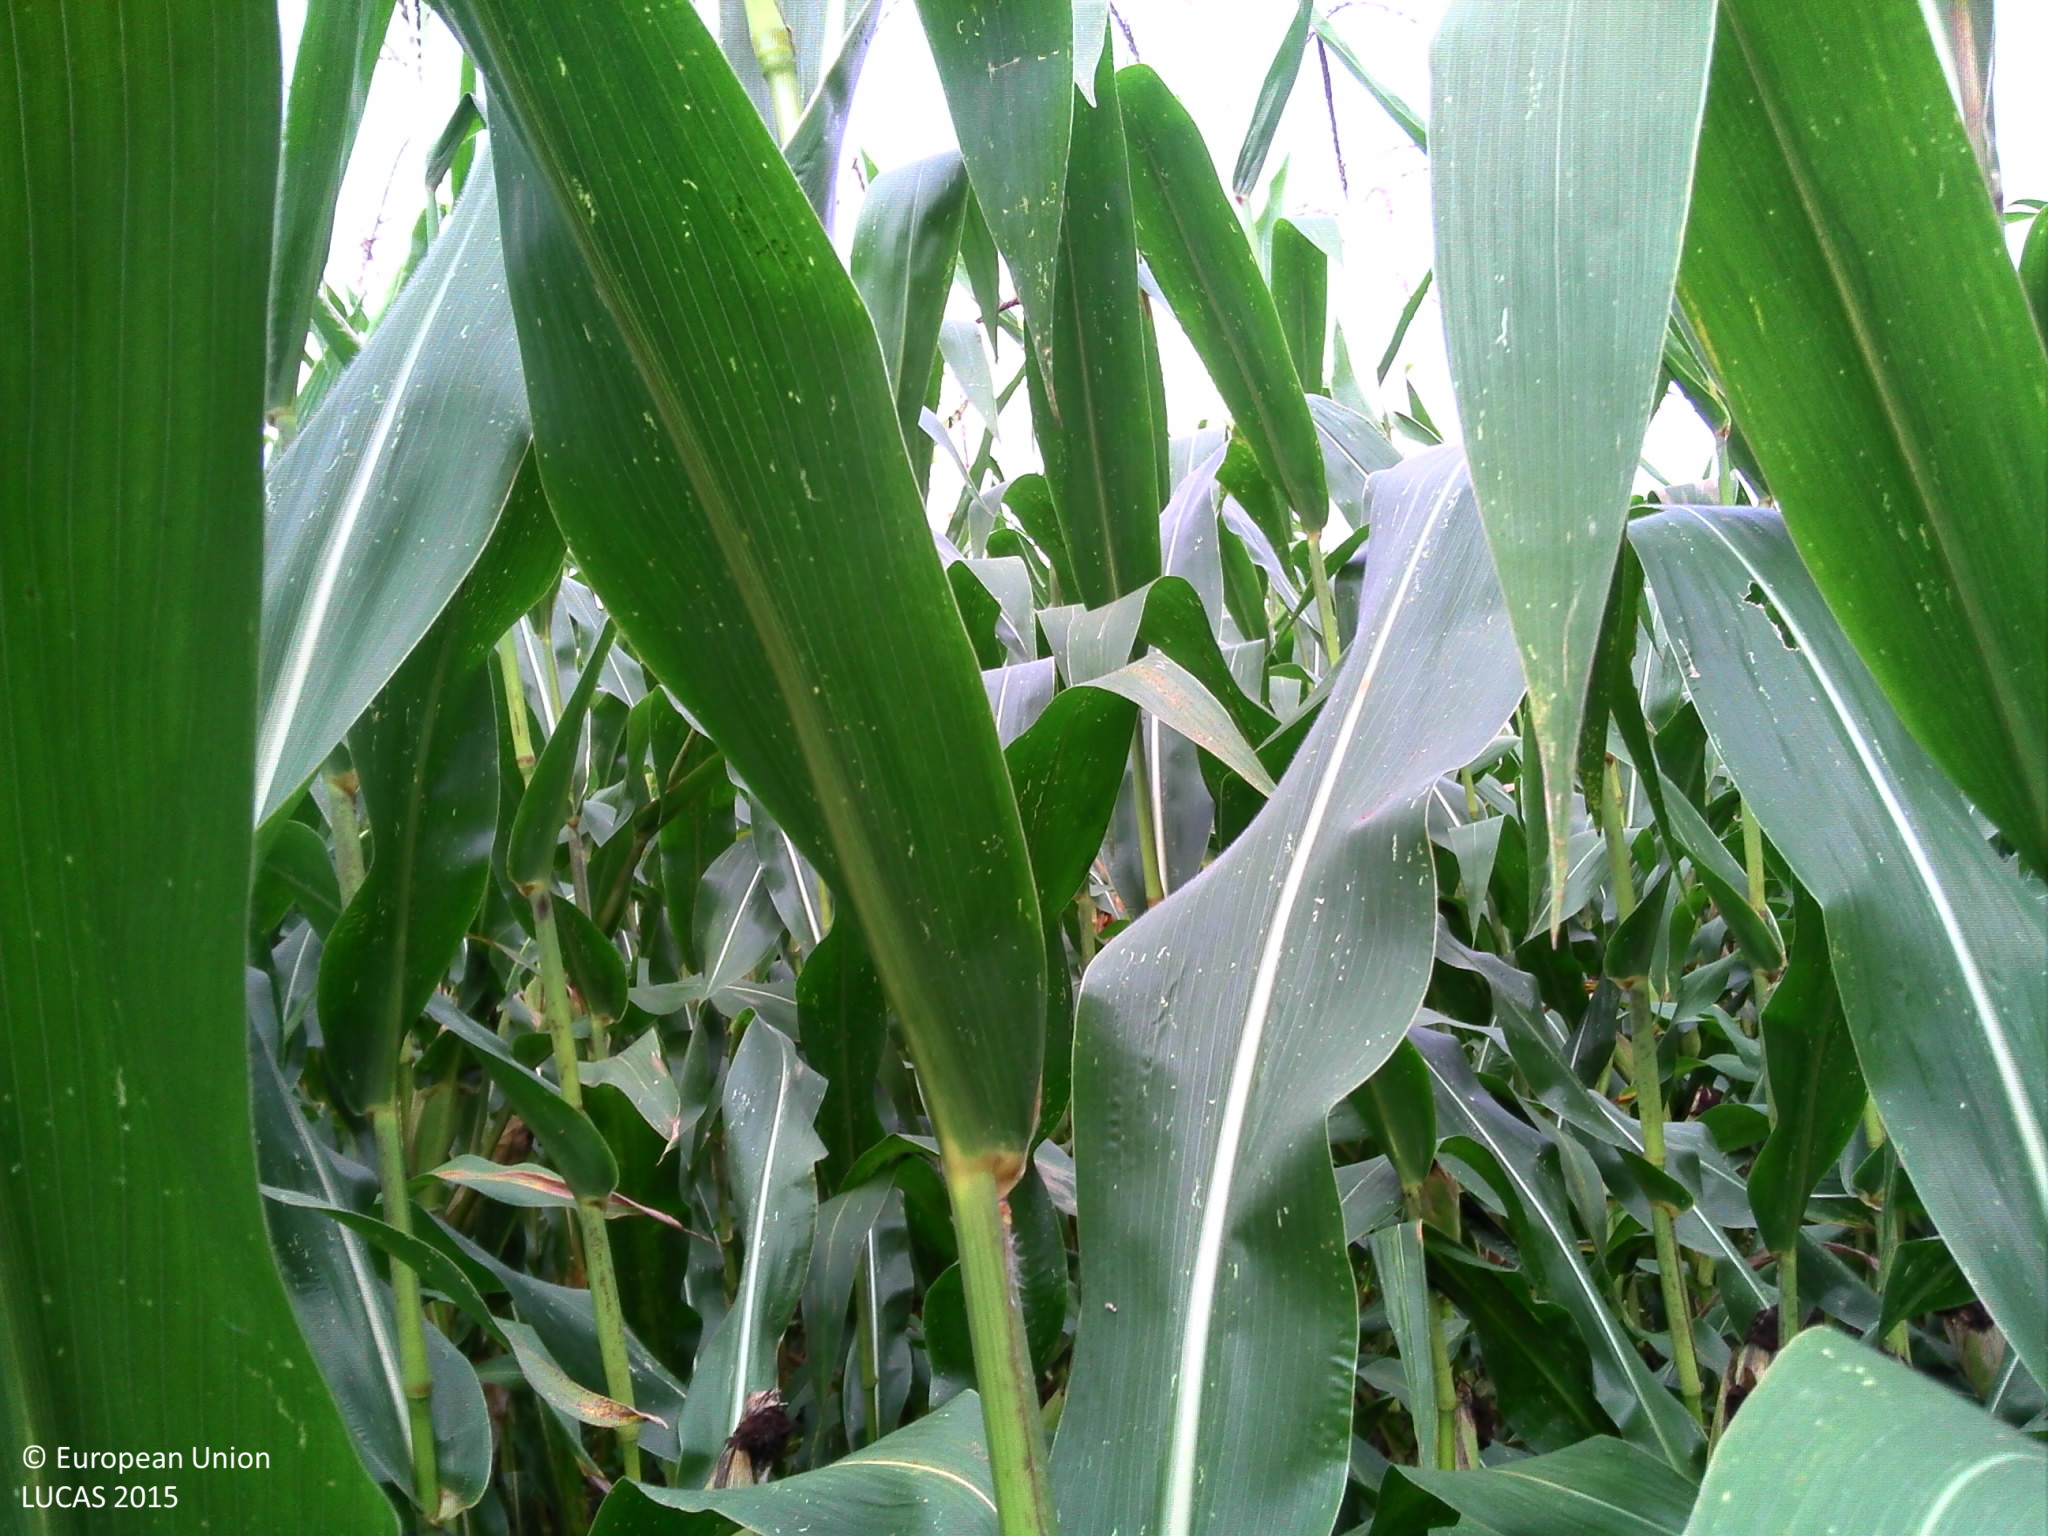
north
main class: Cropland
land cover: Maize
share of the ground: > 75 %
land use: Agriculture (excluding fallow land and kitchen gardens)
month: September
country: FR
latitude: 43.5035
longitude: -0.3603
